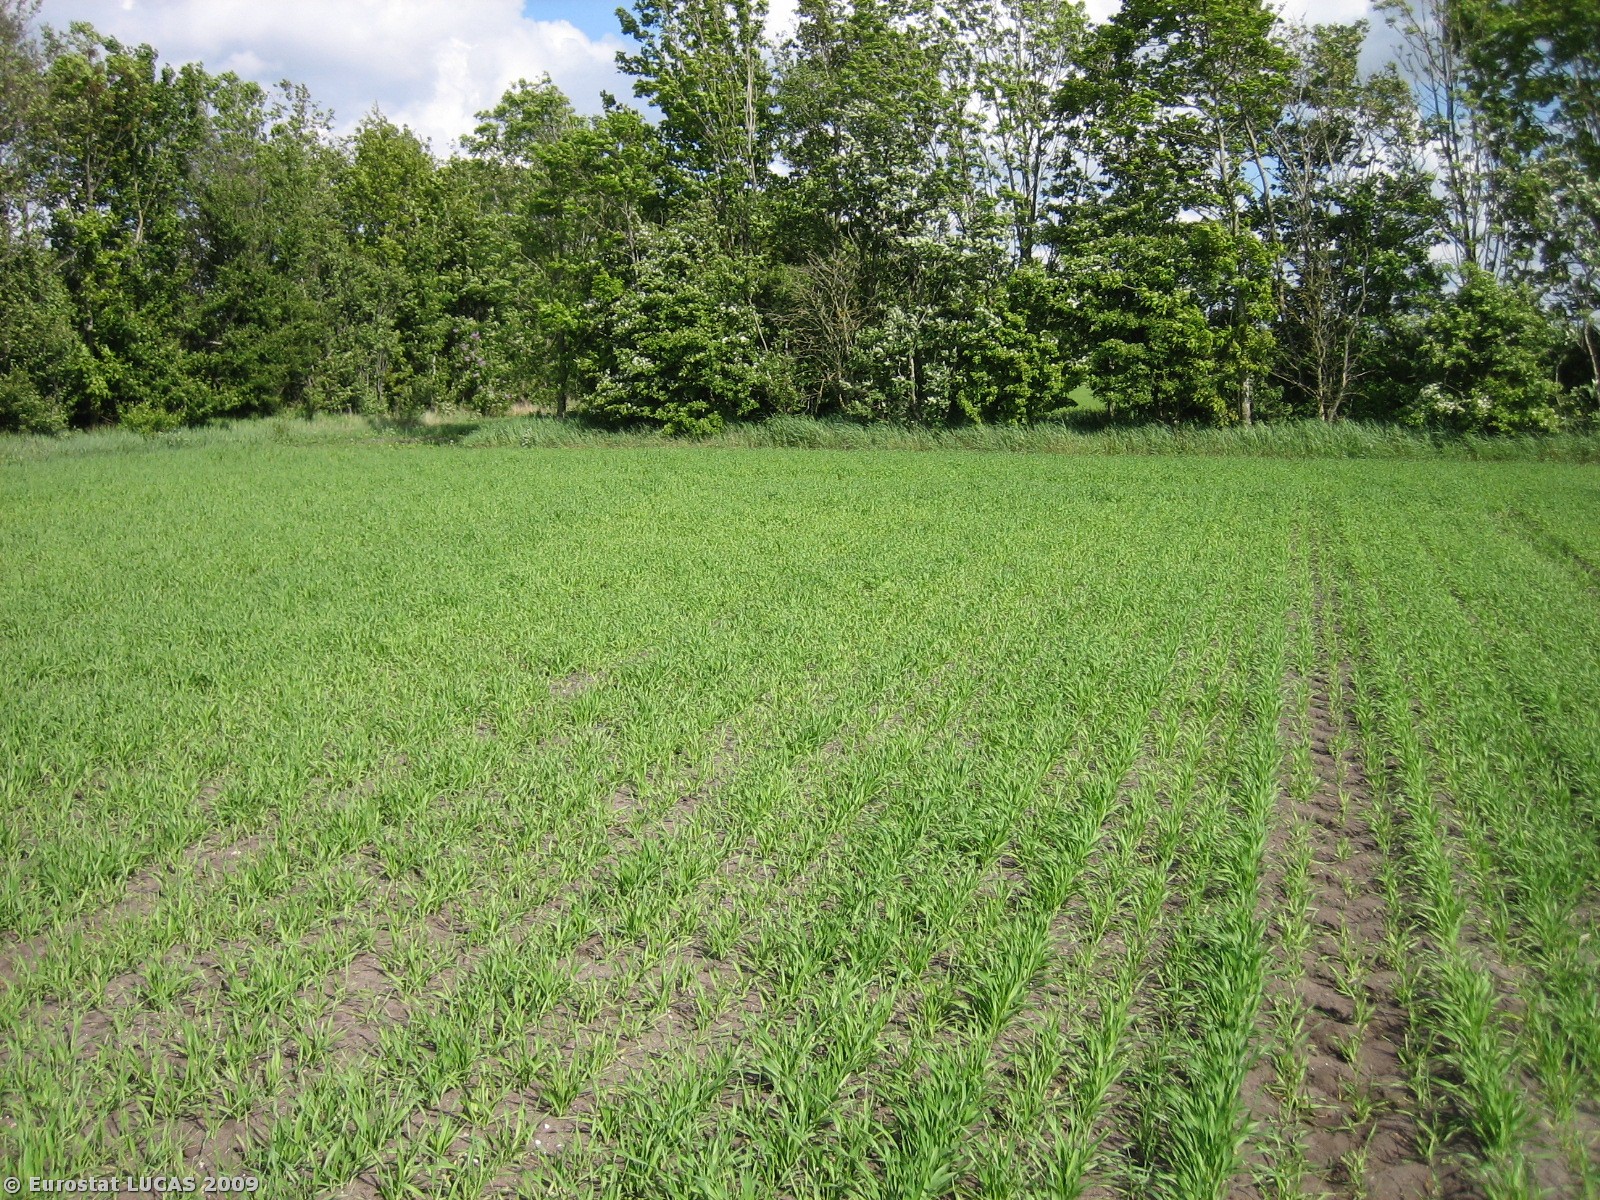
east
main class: Cropland
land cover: Barley
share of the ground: 50 - 75 %
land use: Agriculture (excluding fallow land and kitchen gardens)
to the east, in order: Barley; Broadleaved woodland; Barley; Broadleaved woodland; Grass margins; Potatoes; Coniferous woodland; Barley
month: May
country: DK
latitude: 56.2736
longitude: 8.9838
